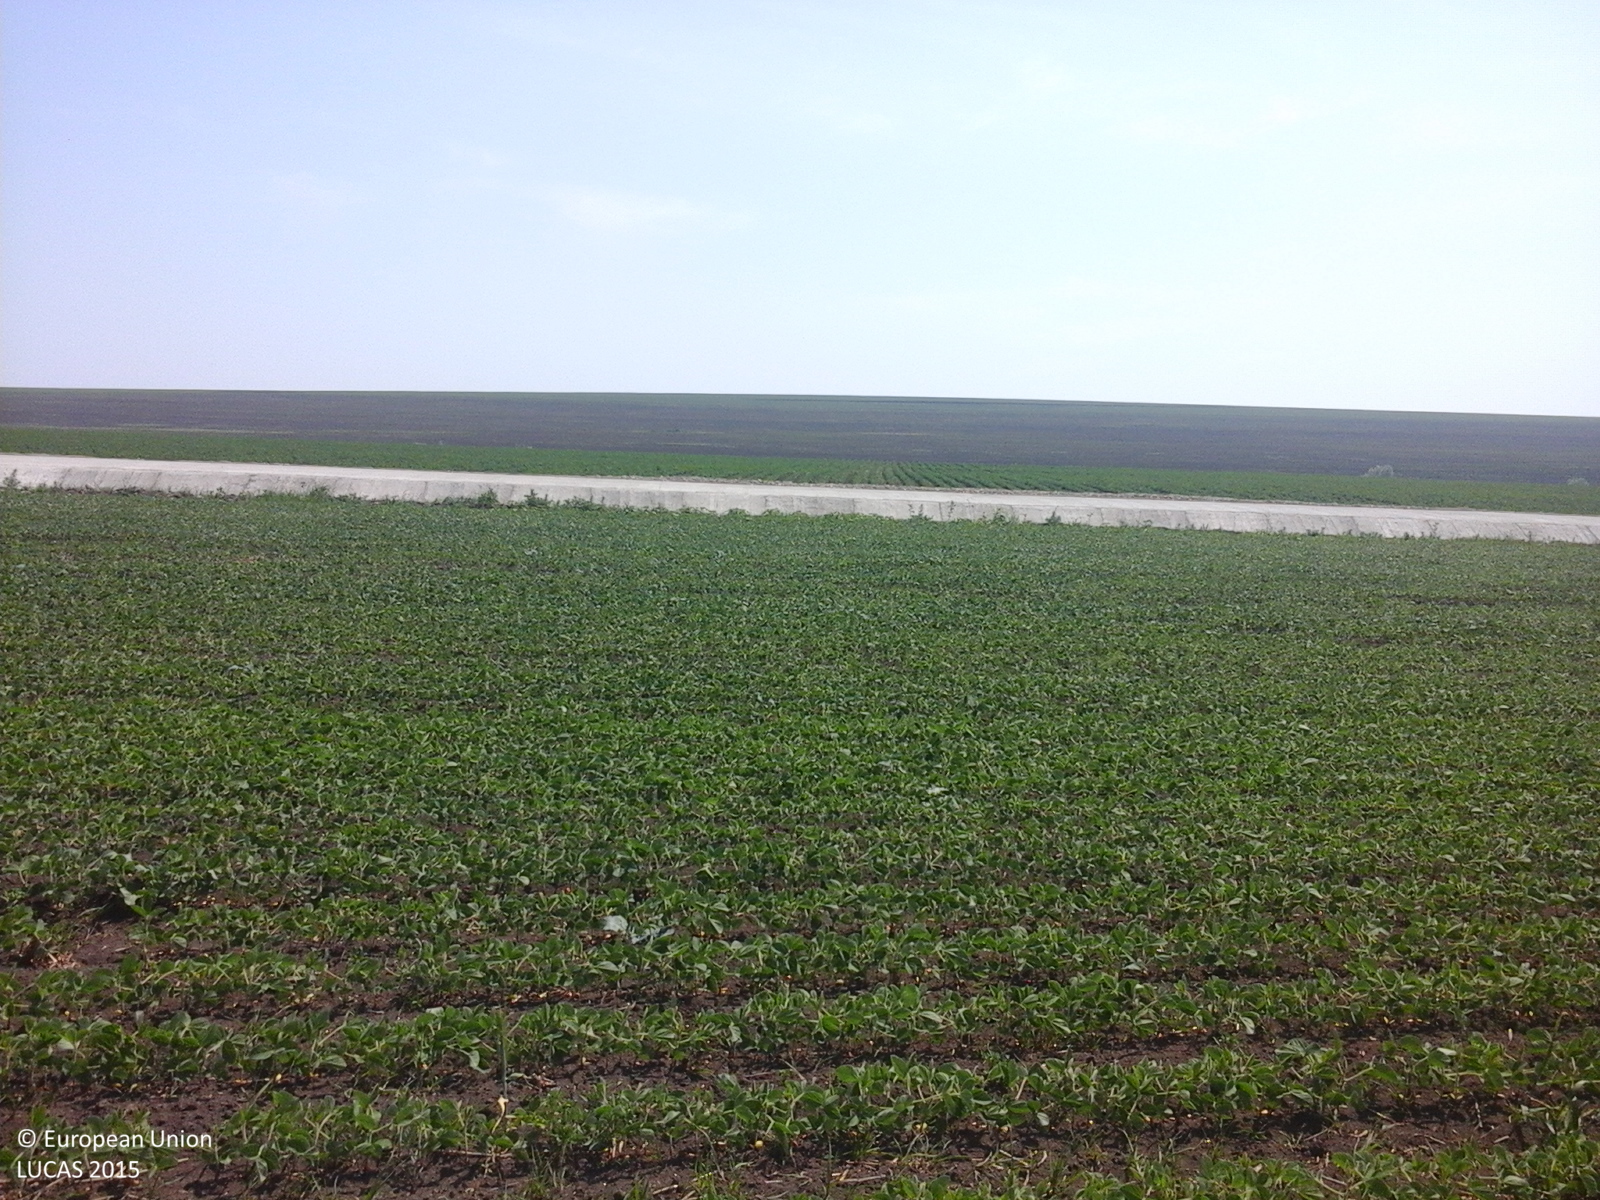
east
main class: Cropland
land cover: Soya
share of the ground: 50 - 75 %
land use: Agriculture (excluding fallow land and kitchen gardens)
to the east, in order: Soya; Grass margins; Paved roads, cycling and walking lanes; Potatoes
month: June
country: RO
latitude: 46.8570
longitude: 26.6276
